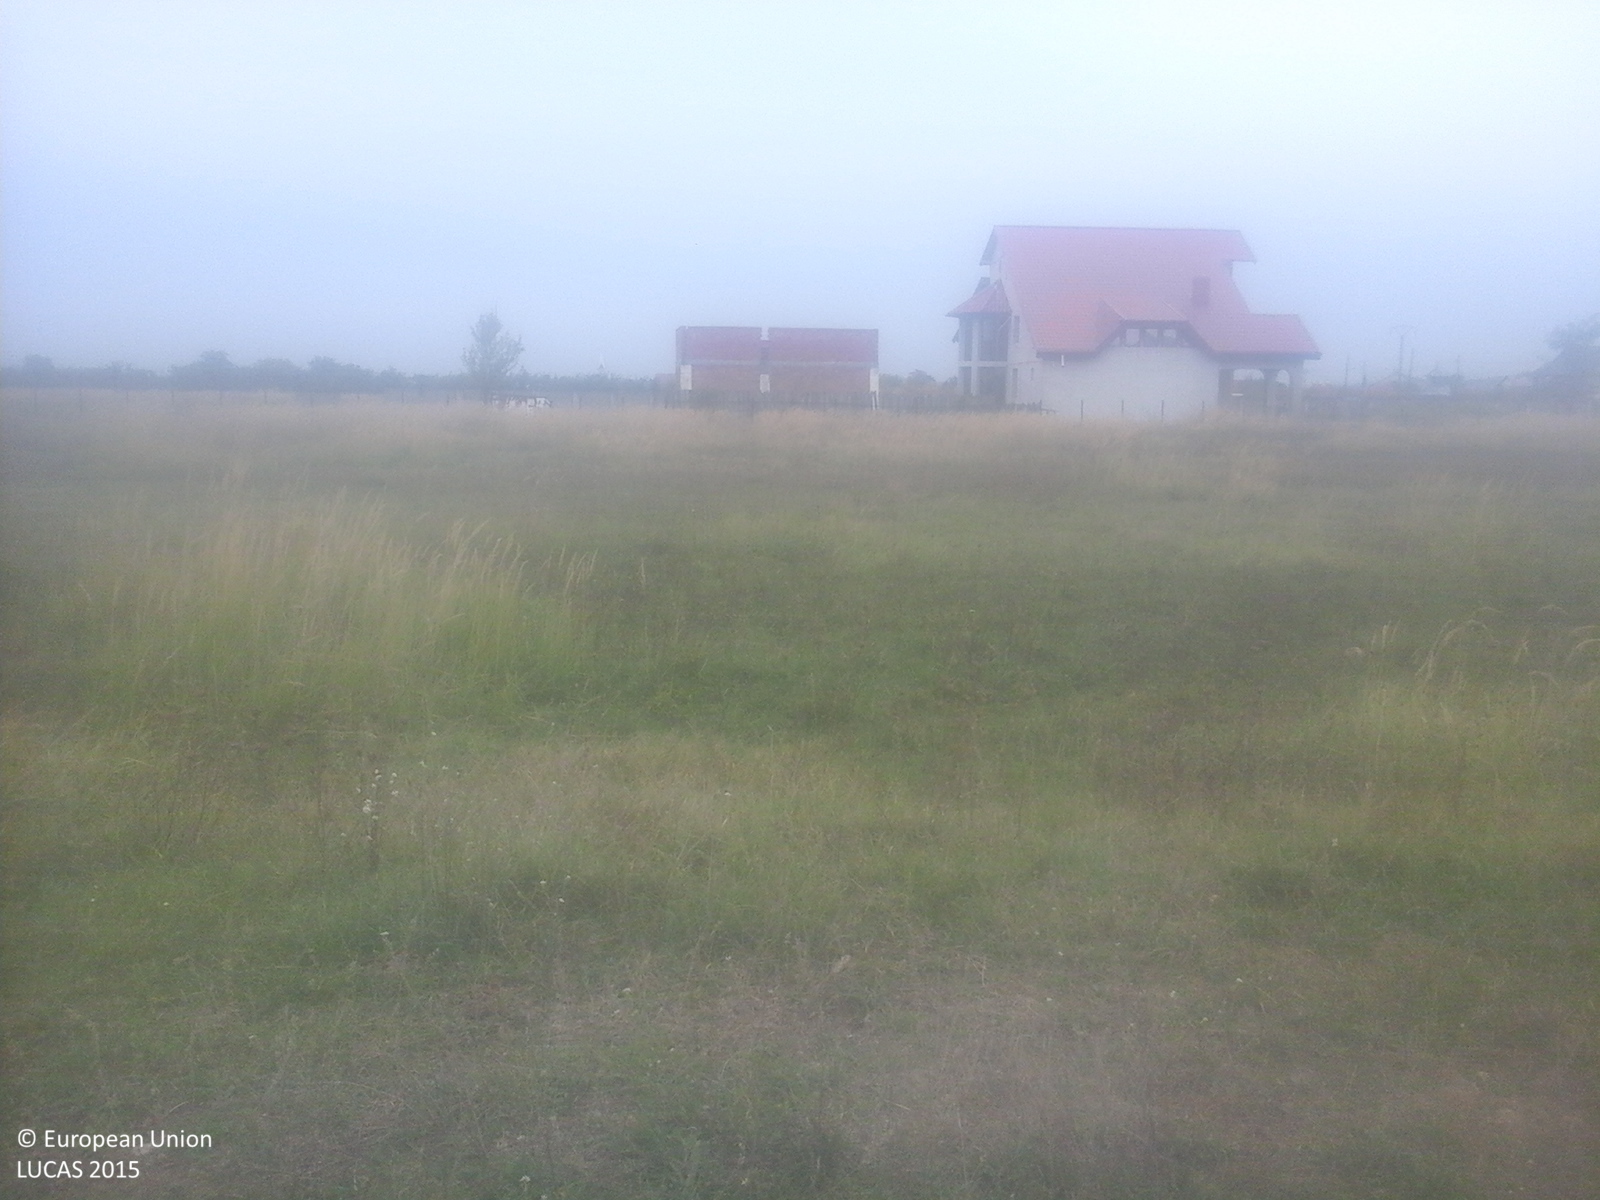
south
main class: Artificial land
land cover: Non built-up linear features
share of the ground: > 75 %
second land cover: Grassland without tree/shrub cover
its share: > 75 %
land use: Road transport
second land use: Residential
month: October
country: RO
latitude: 44.9716
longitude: 25.7616
